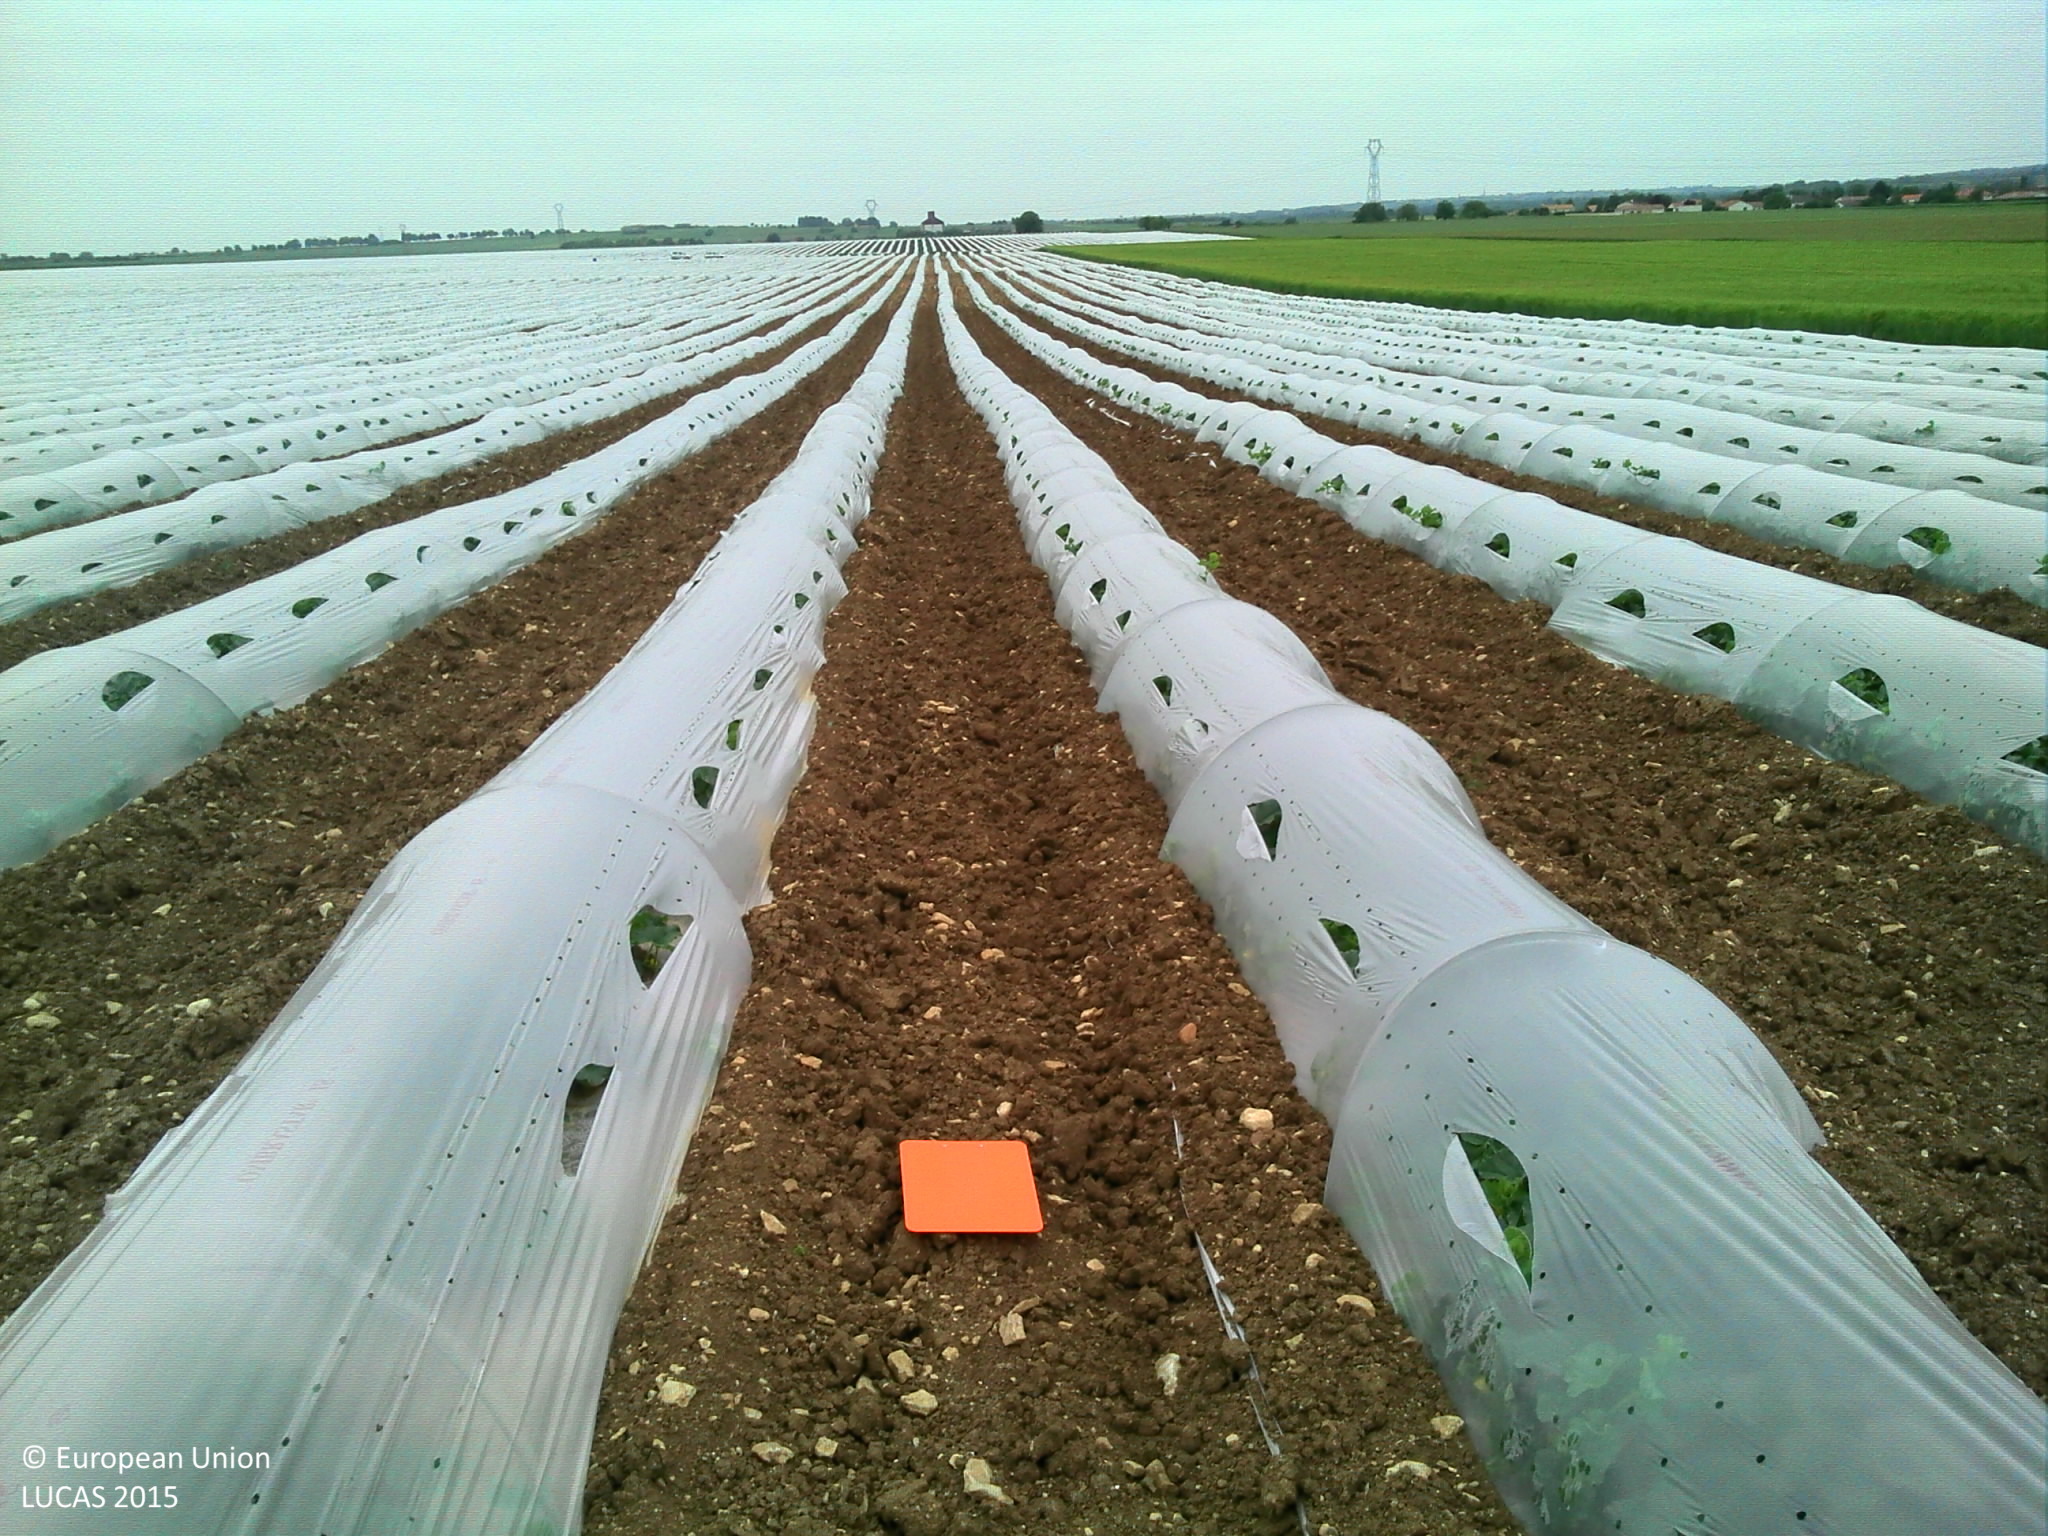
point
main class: Cropland
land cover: Other fresh vegetables
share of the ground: 50 - 75 %
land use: Agriculture (excluding fallow land and kitchen gardens)
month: May
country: FR
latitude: 46.7038
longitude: 0.2619
